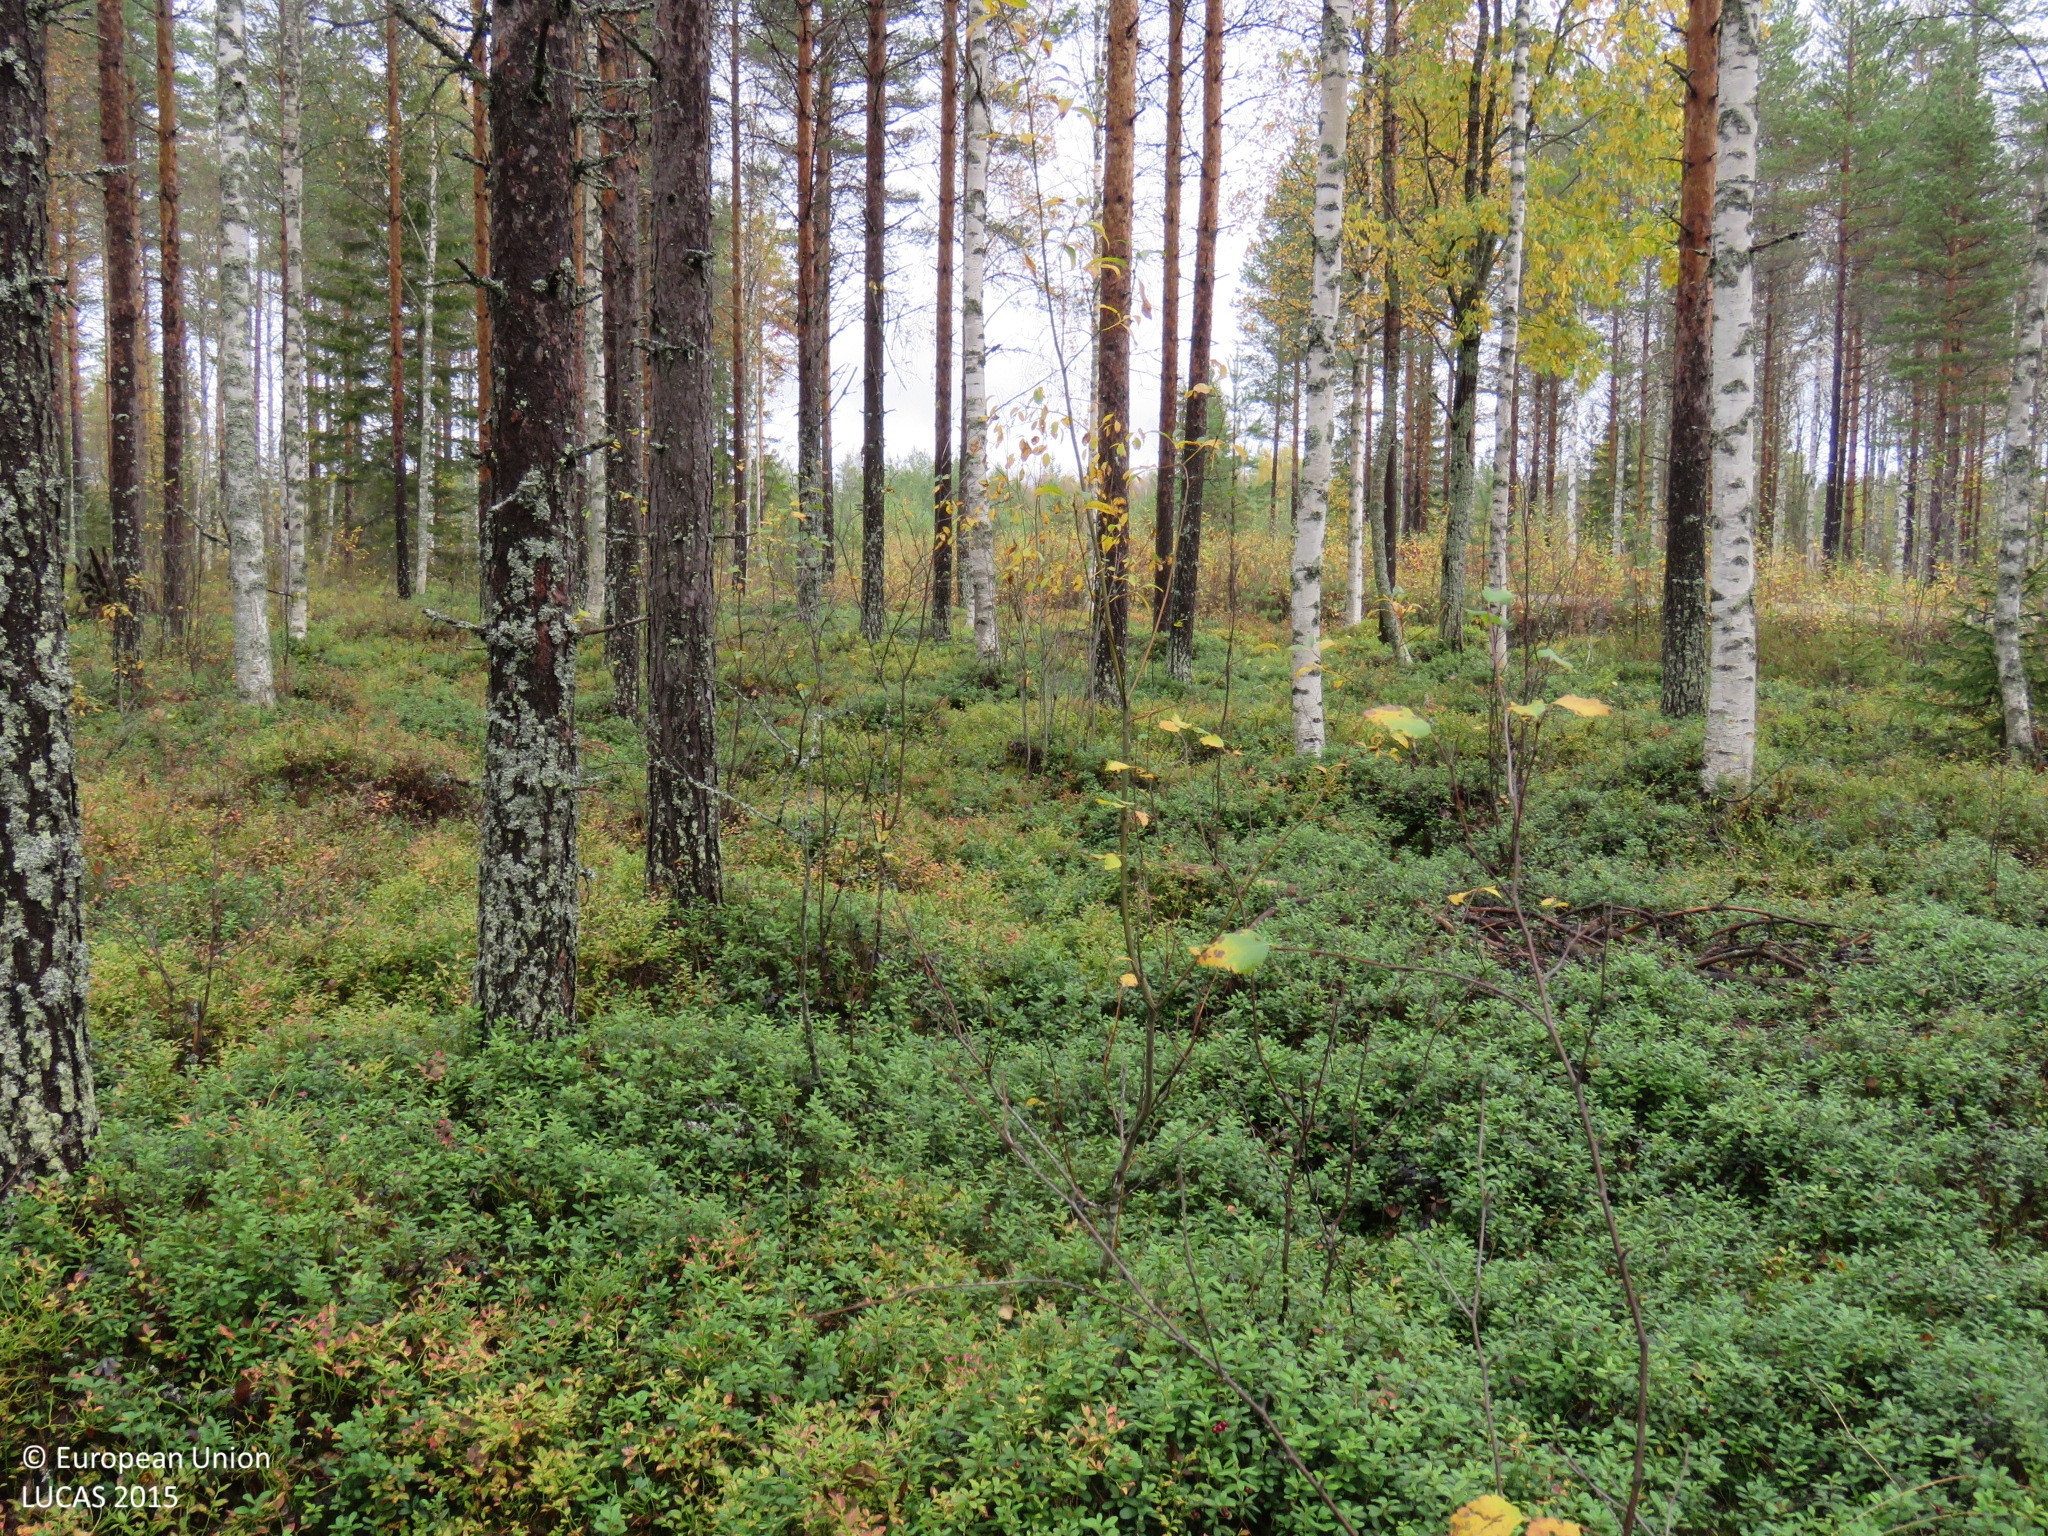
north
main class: Woodland
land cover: Pine dominated mixed woodland
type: boreal forest
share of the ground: 50 - 75 %
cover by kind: broadleaved forest trees 40 %, coniferous forest trees 30 %, shrubs 20 %, herbaceous plants 5 %, lichens and mosses 5 %
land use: Forestry
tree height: > 5 m
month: September
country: FI
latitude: 64.8787
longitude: 26.8604
